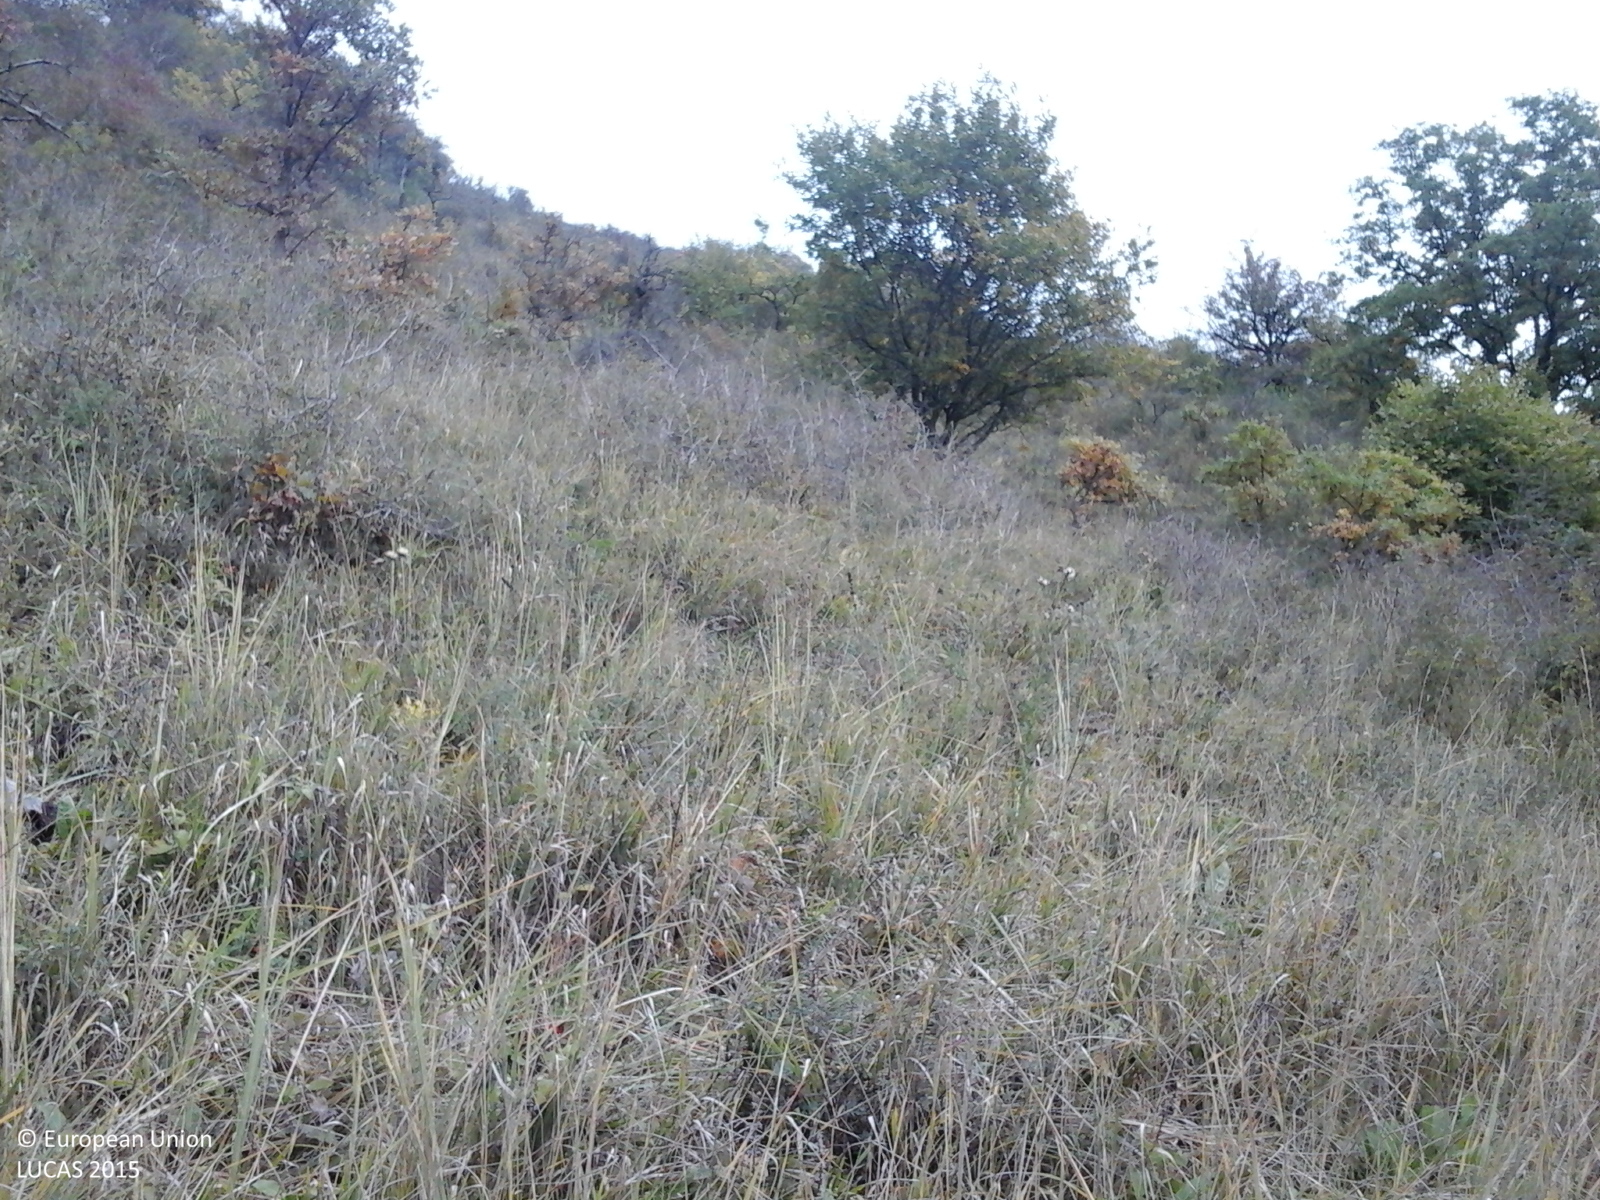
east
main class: Grassland
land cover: Grassland with sparse tree/shrub cover
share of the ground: > 75 %
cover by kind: herbaceous plants 85 %, shrubs 10 %, broadleaved forest trees 5 %
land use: Agriculture (excluding fallow land and kitchen gardens)
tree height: < 5 m
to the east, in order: Grassland with sparse tree/shrub cover; Shrubland with sparse tree cover; Broadleaved woodland; Shrubland with sparse tree cover; Grassland with sparse tree/shrub cover; Shrubland with sparse tree cover; Grassland without tree/shrub cover
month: October
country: RO
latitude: 46.3373
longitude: 24.9444
